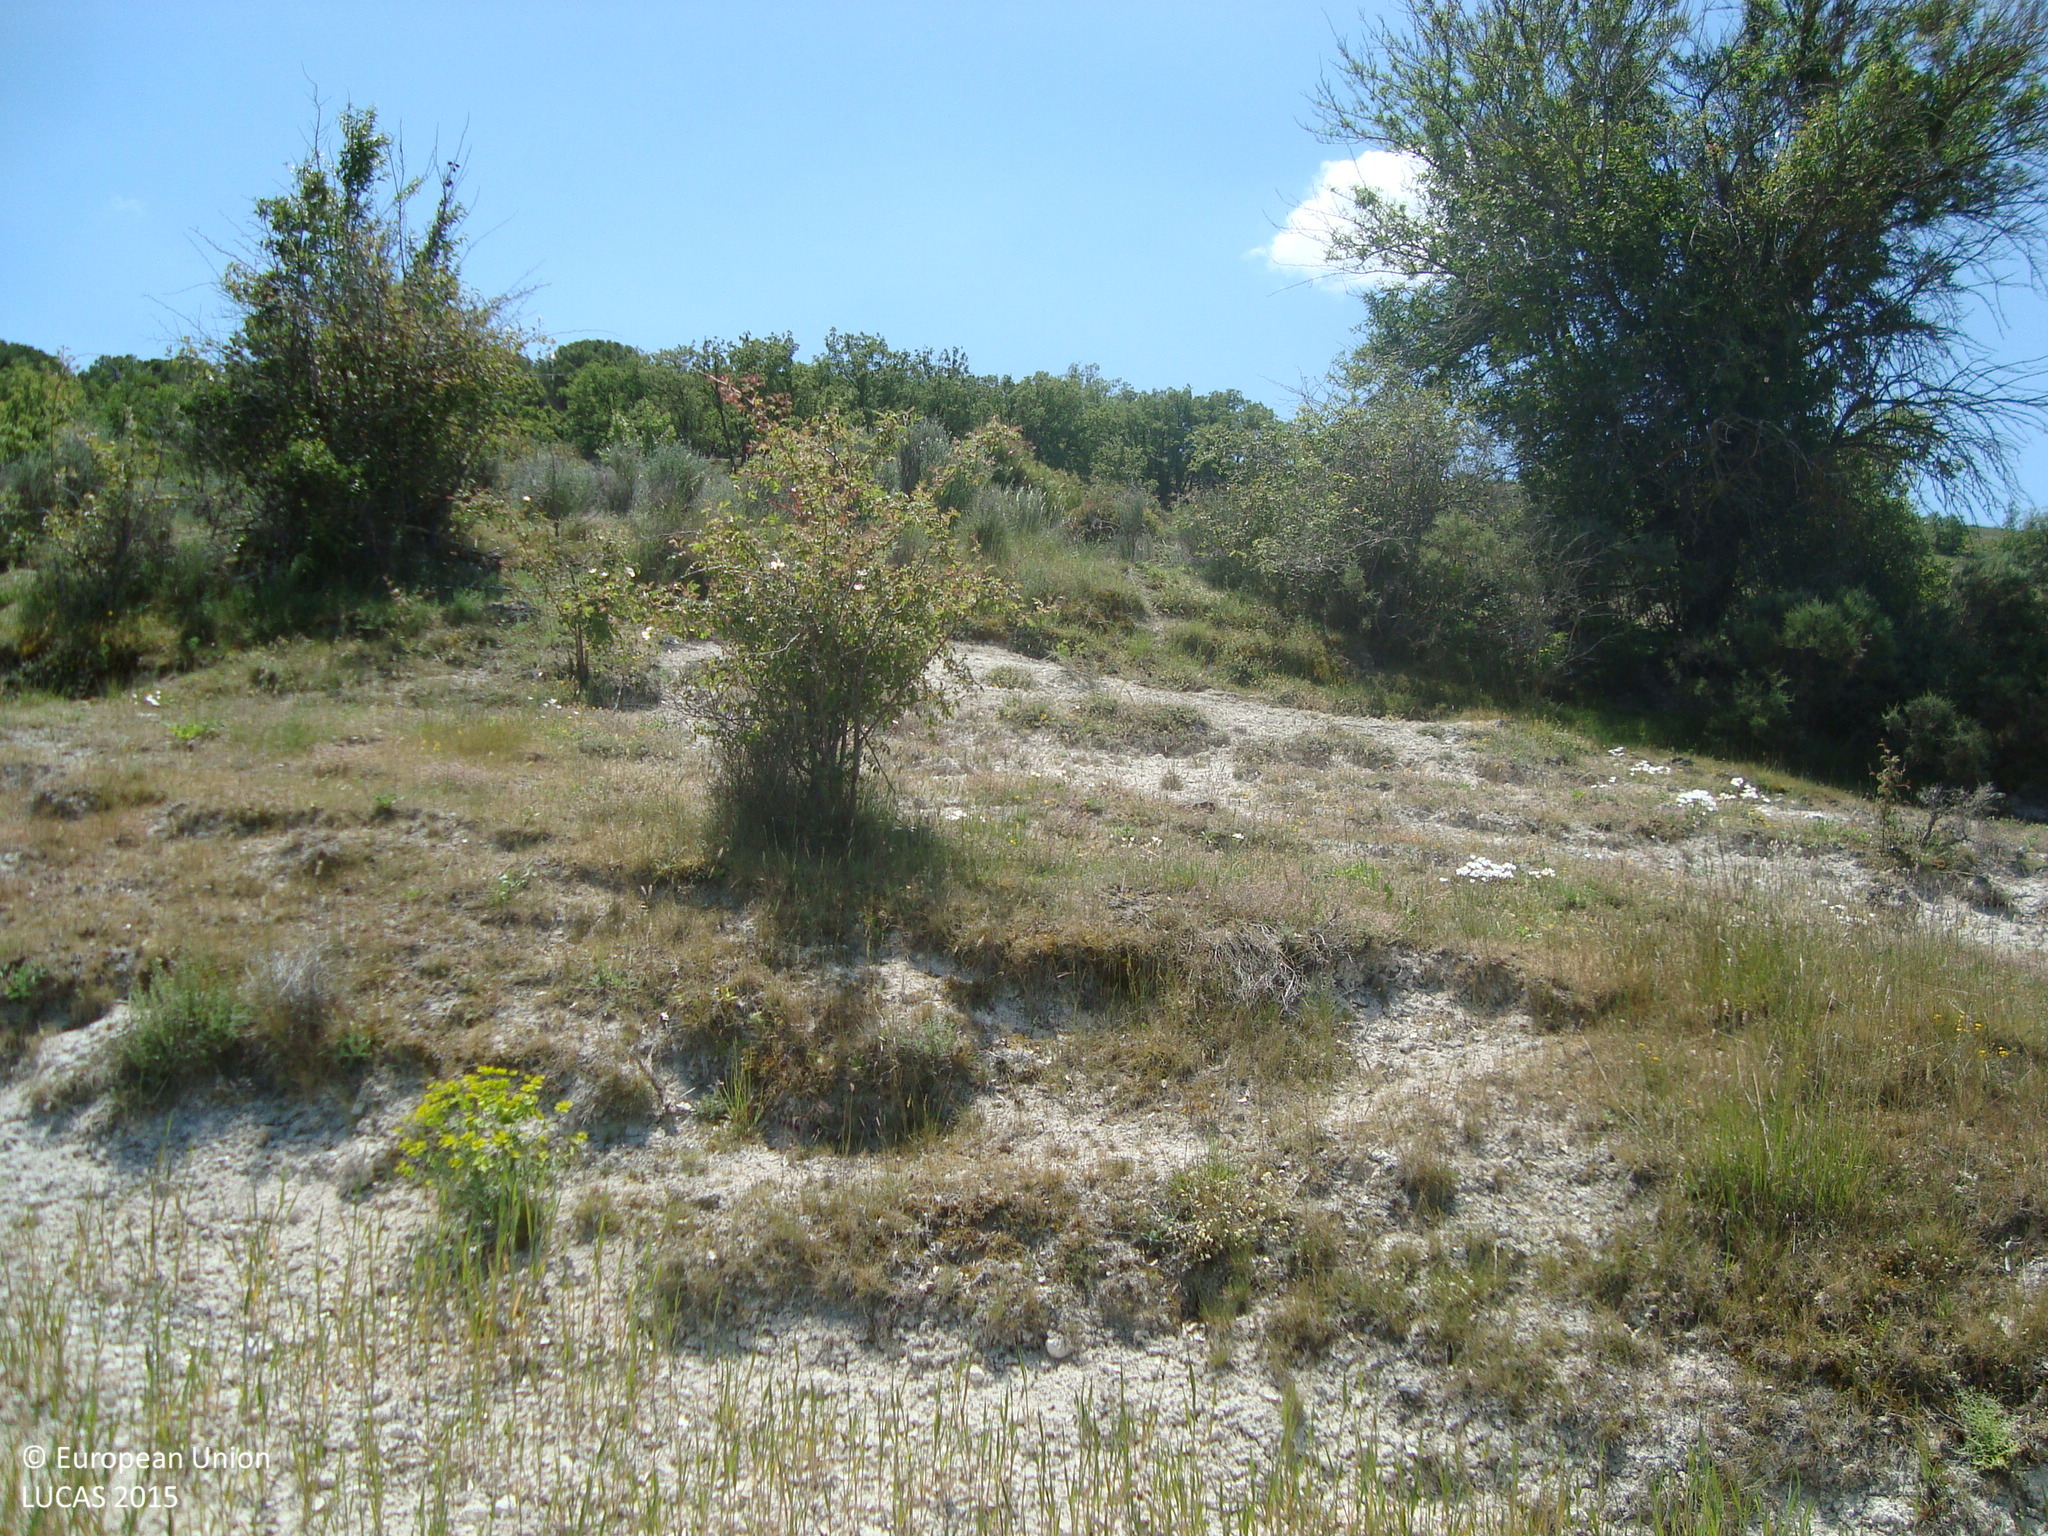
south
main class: Cropland
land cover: Common wheat
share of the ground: 50 - 75 %
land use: Agriculture (excluding fallow land and kitchen gardens)
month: May
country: ES
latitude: 41.5459
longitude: -4.1440
